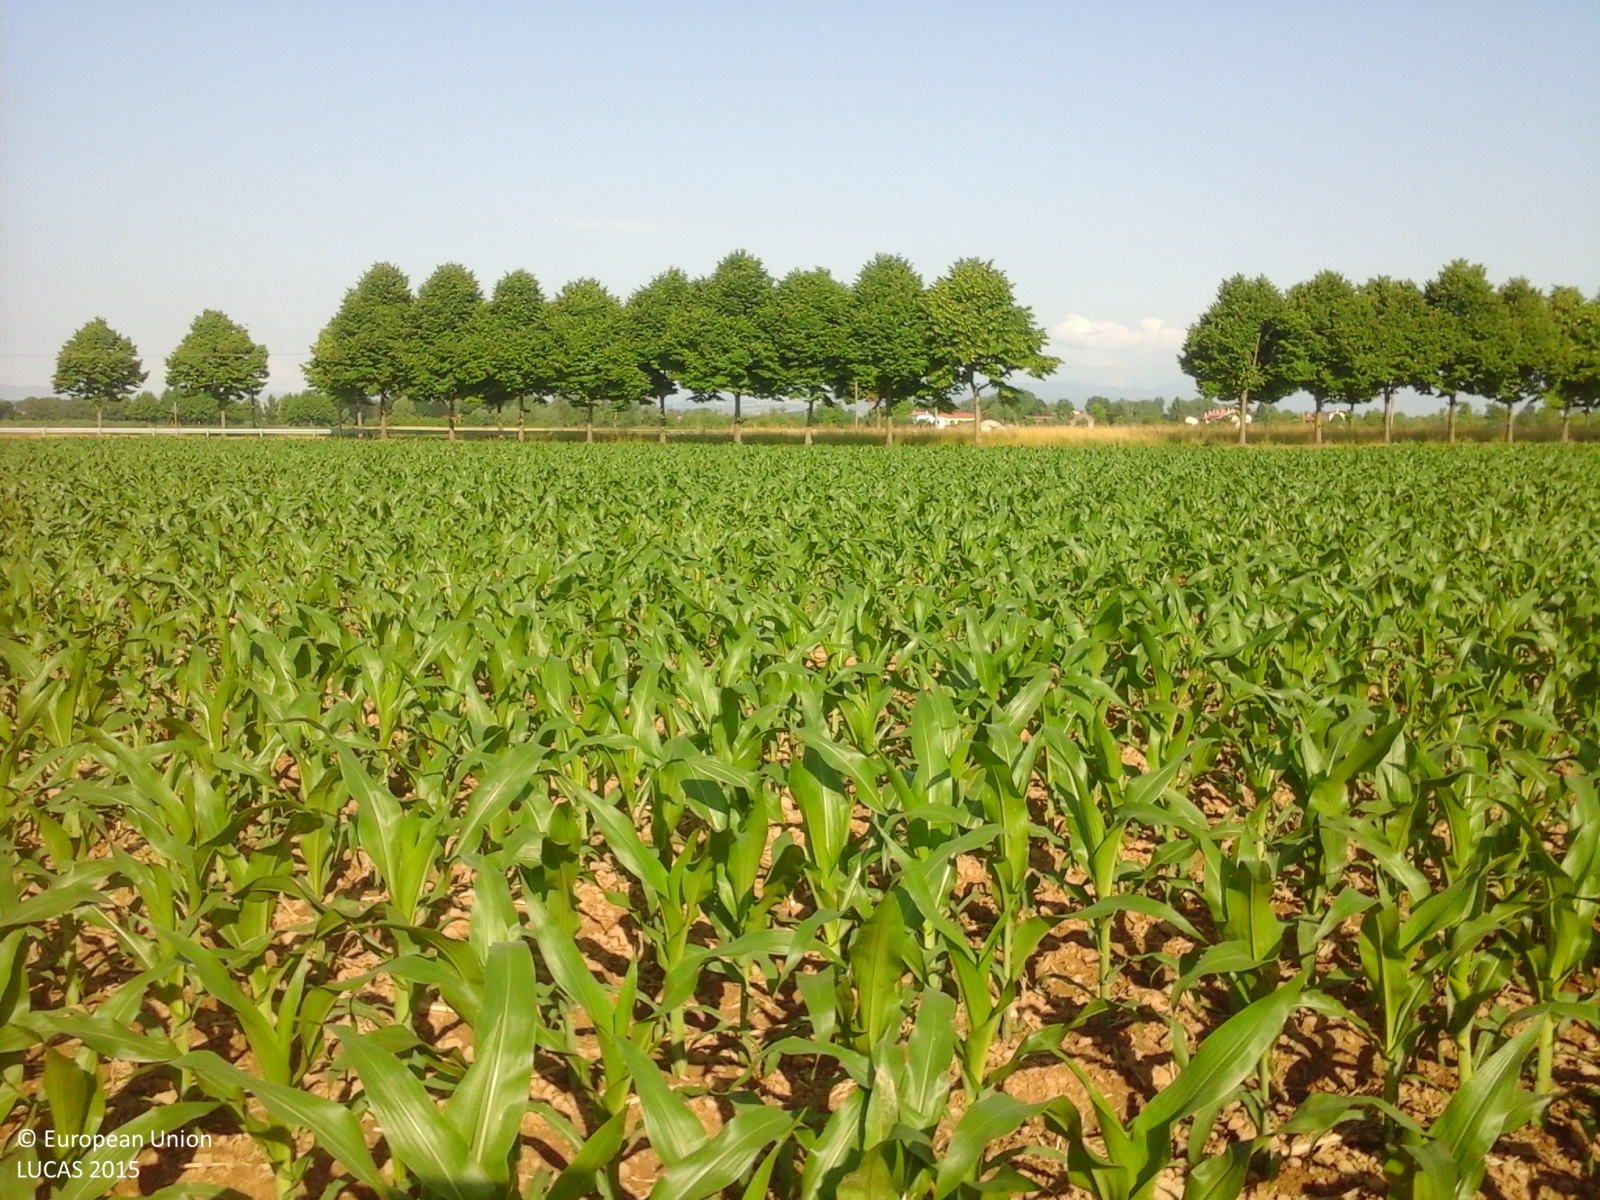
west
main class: Cropland
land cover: Maize
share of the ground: 50 - 75 %
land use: Agriculture (excluding fallow land and kitchen gardens)
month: May
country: IT
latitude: 45.5640
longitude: 11.6245
